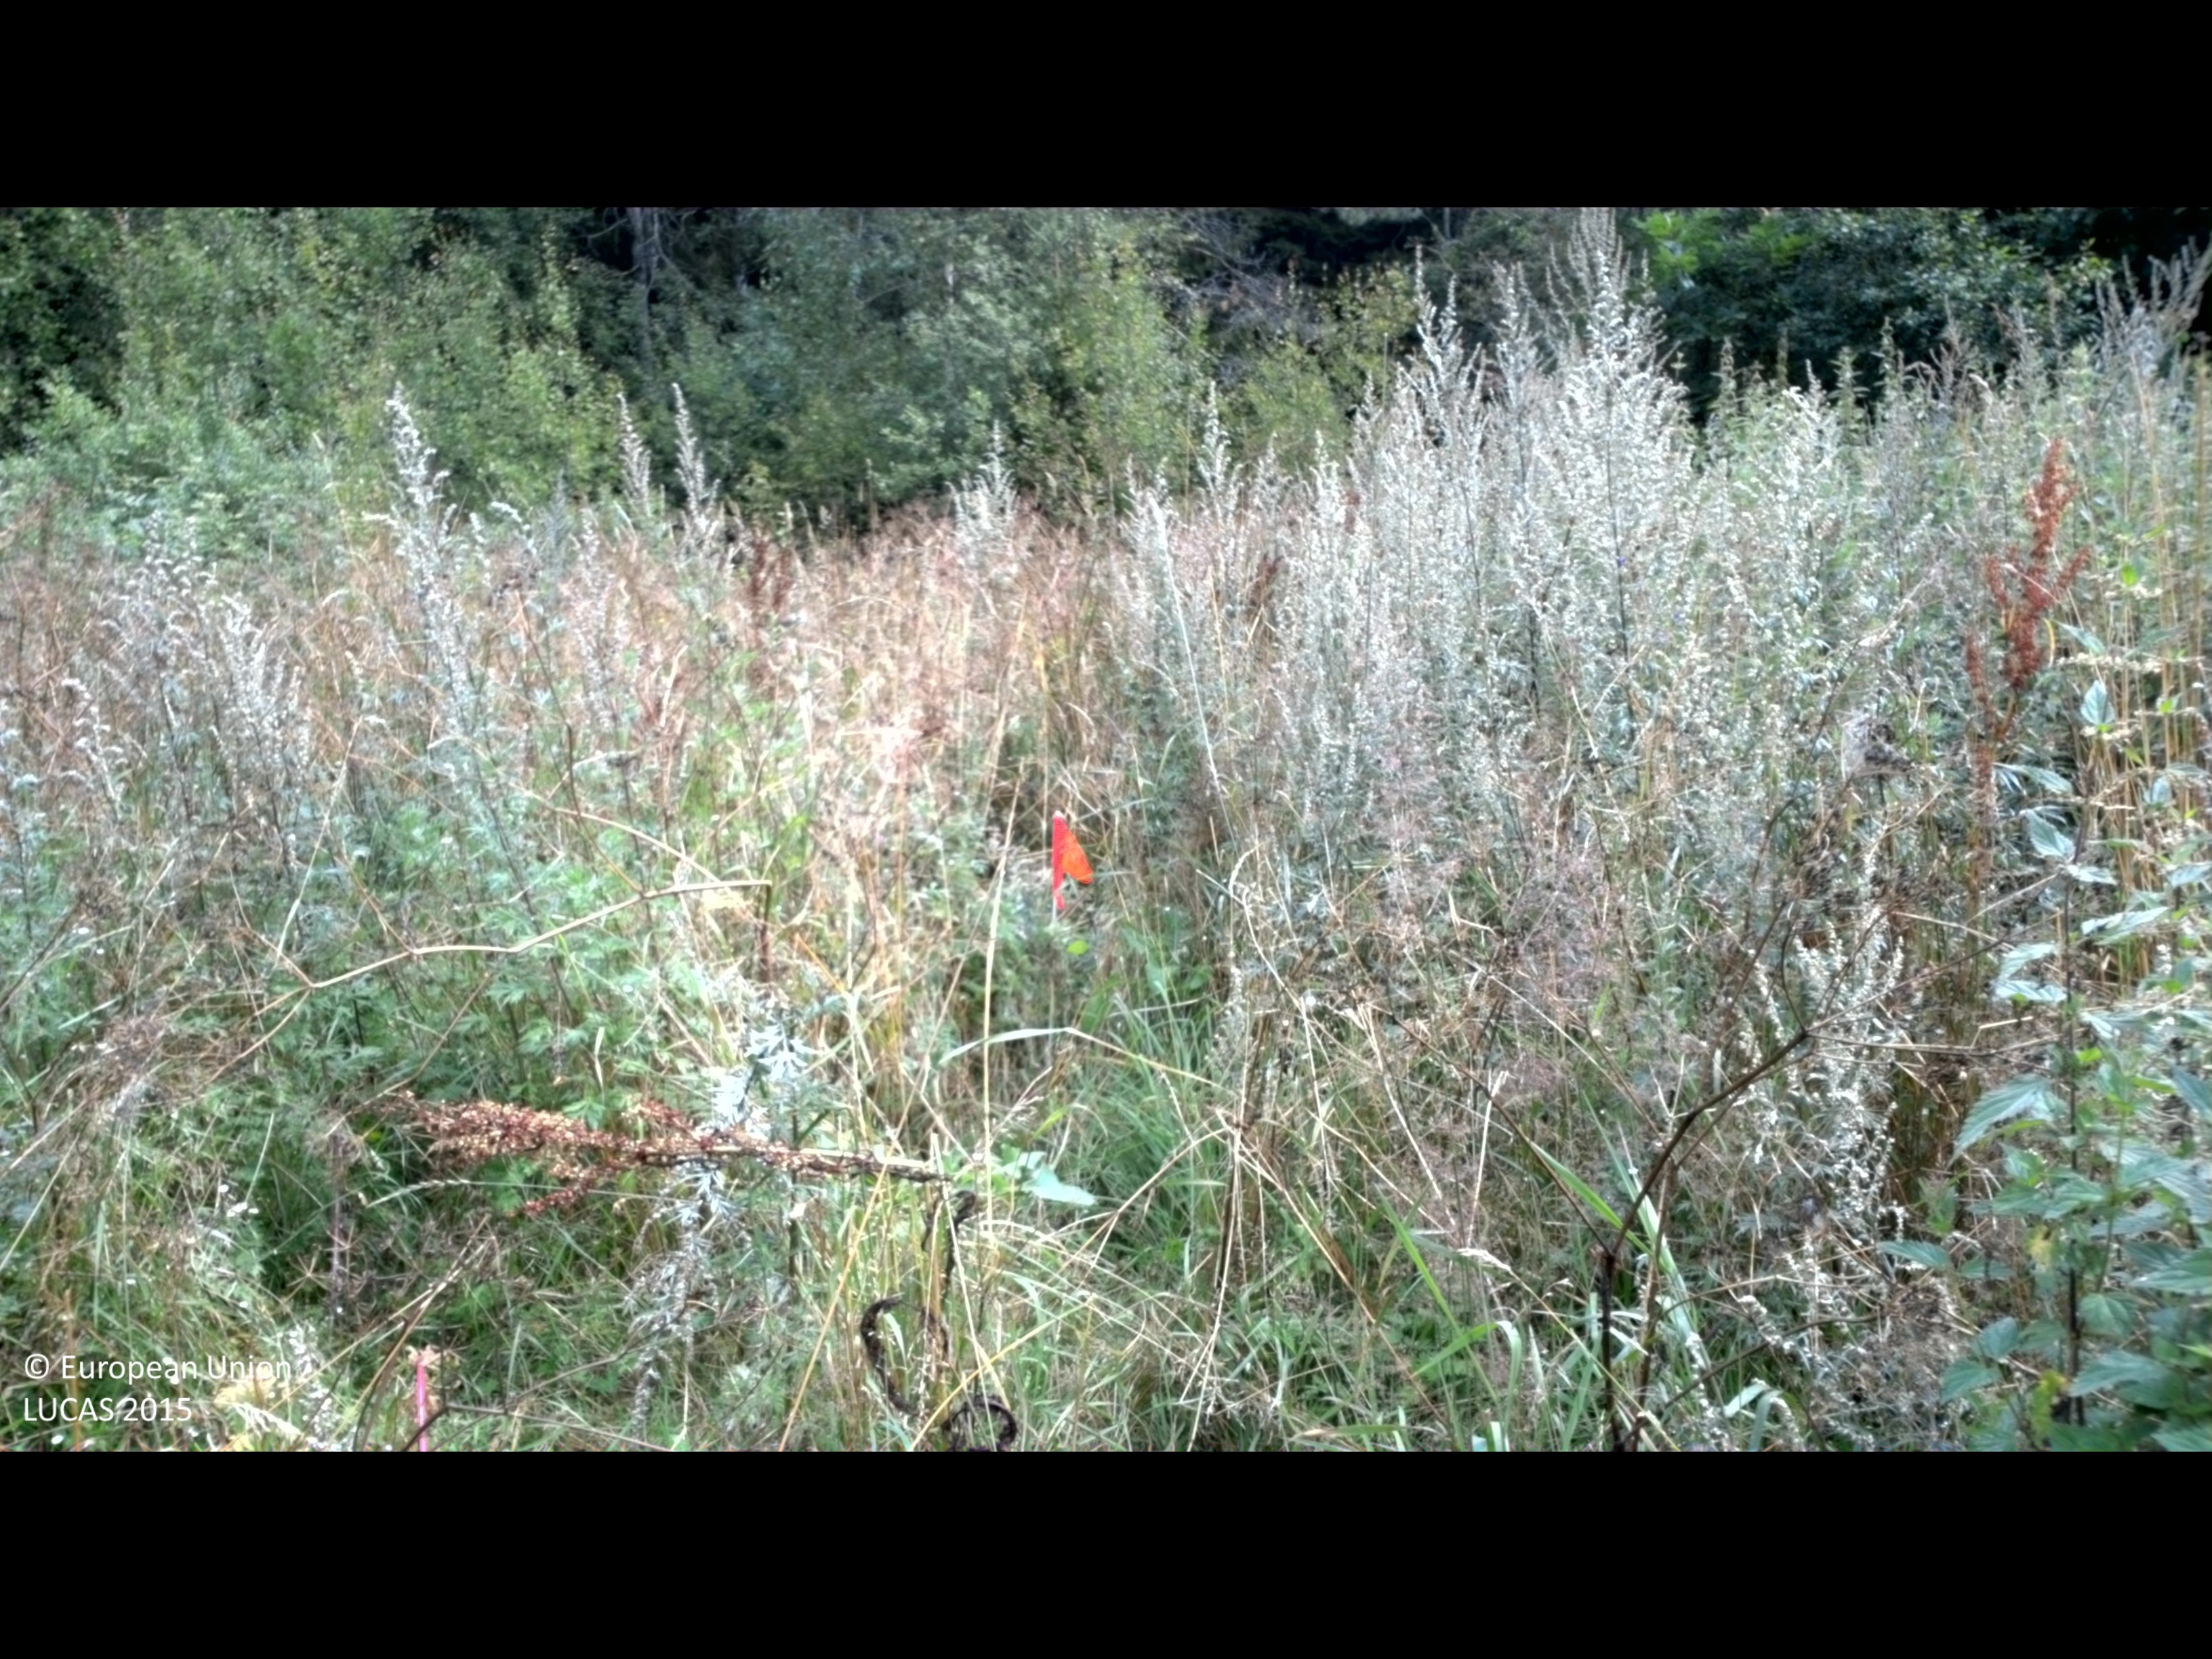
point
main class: Grassland
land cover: Grassland without tree/shrub cover
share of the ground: > 75 %
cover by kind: herbaceous plants 100 %
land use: Abandoned areas
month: August
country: SE
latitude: 56.3594
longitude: 15.0321
